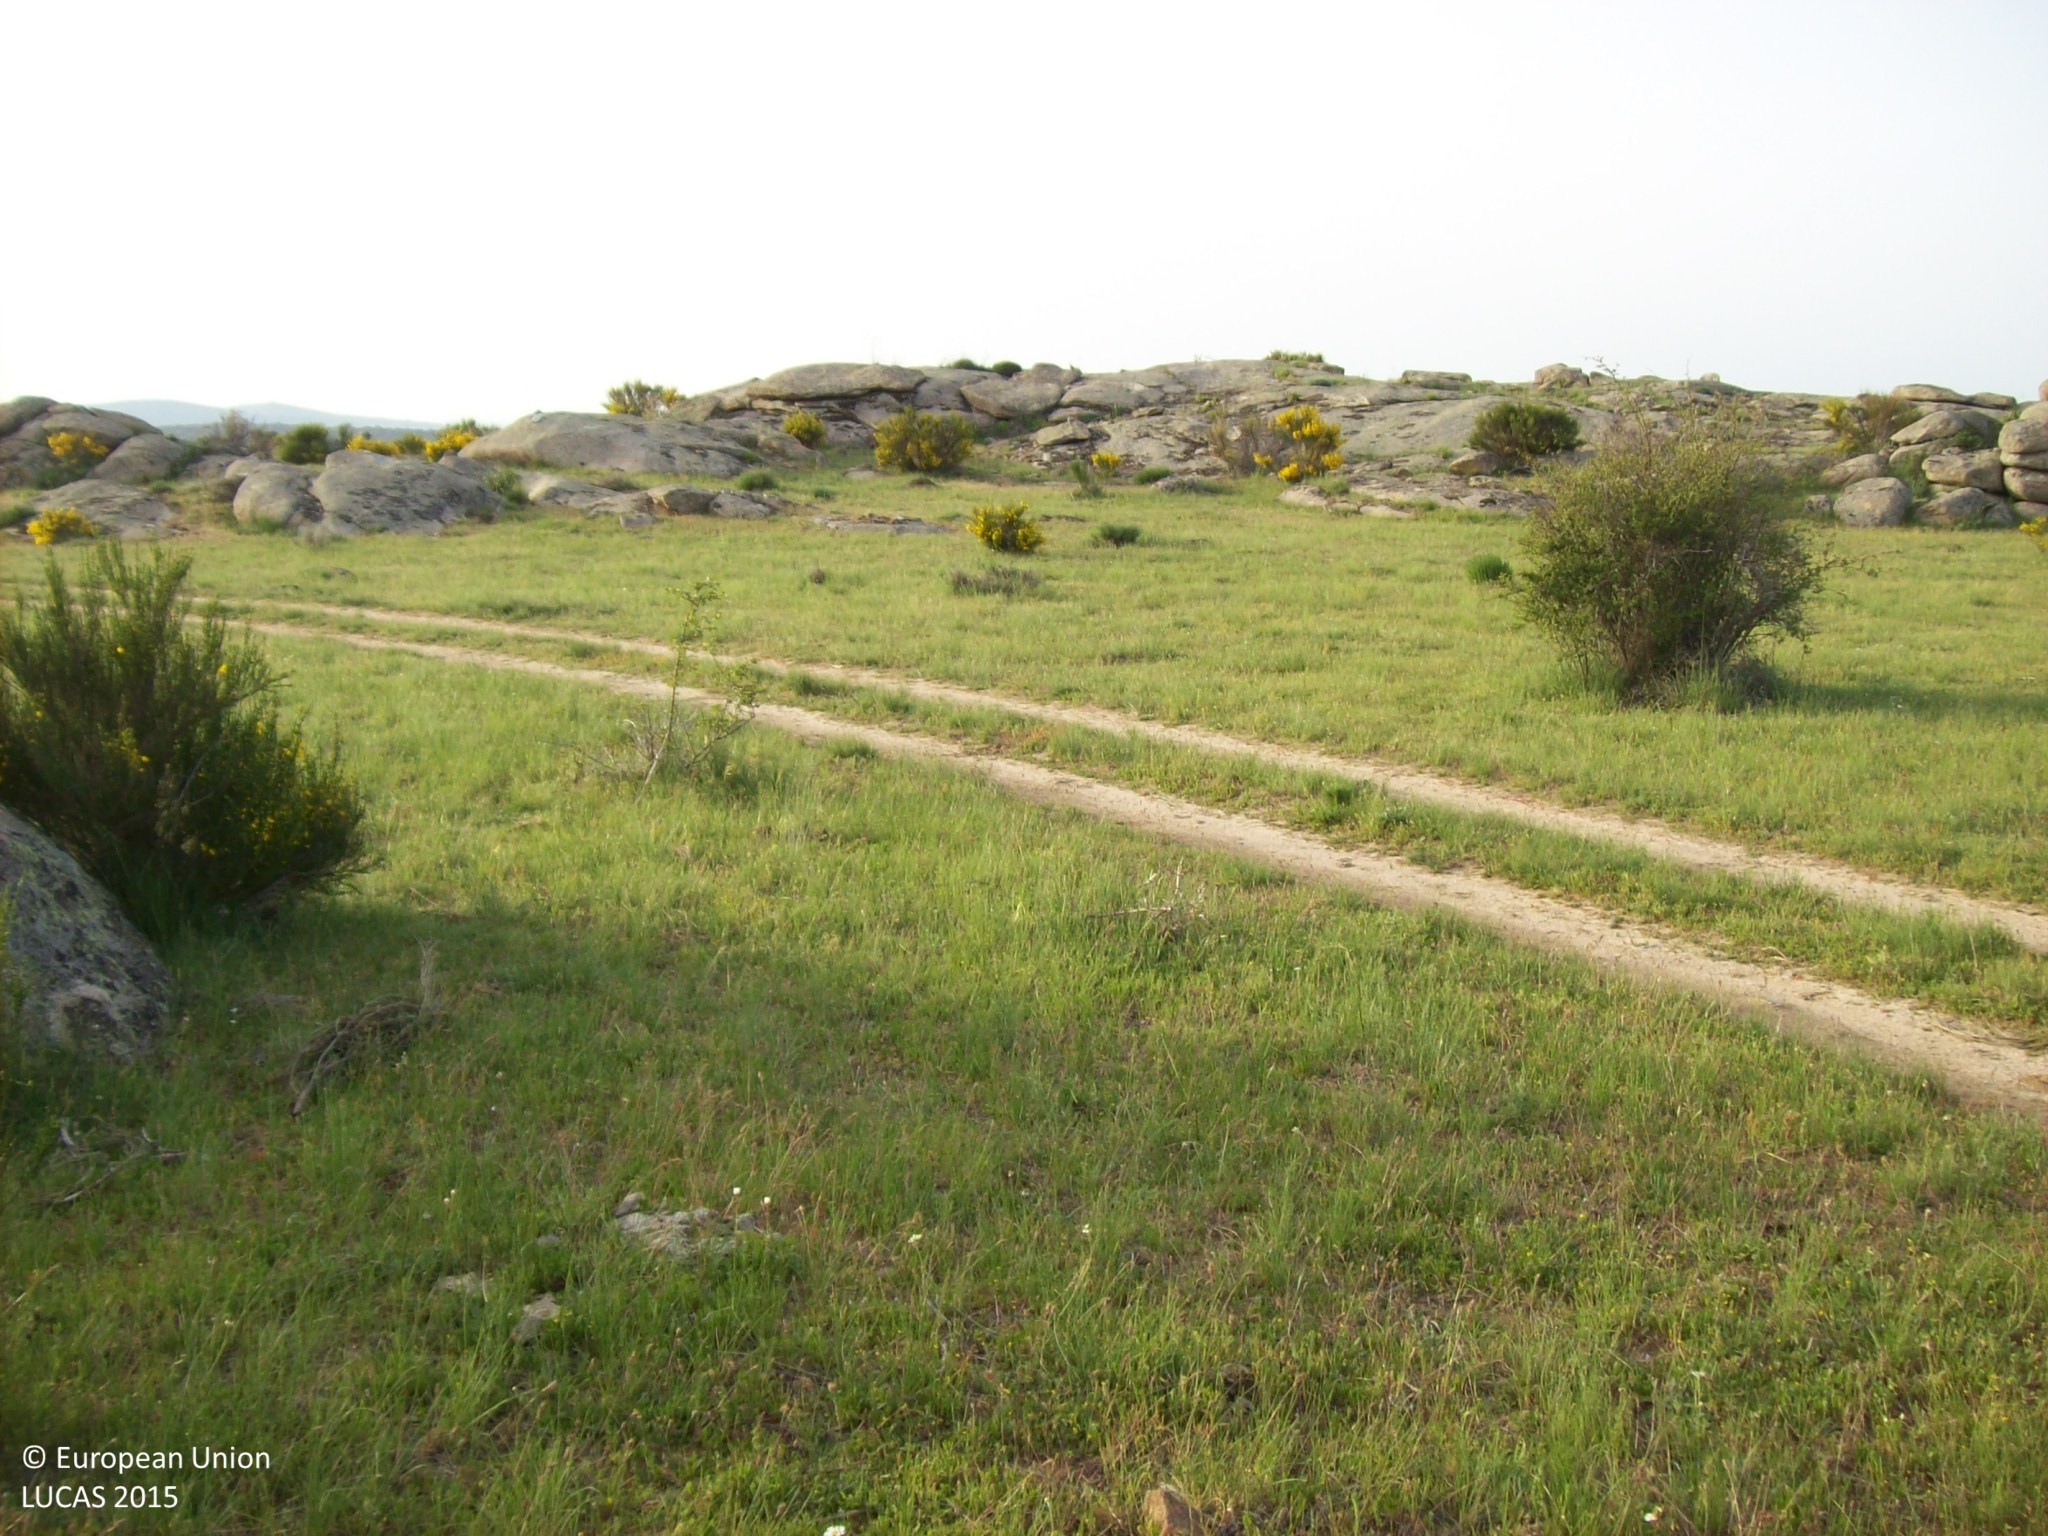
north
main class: Shrubland
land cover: Shrubland without tree cover
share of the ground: 10 - 25 %
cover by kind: consolidated bare surface 40 %, herbaceous plants 35 %, shrubs 20 %
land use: Agriculture (excluding fallow land and kitchen gardens)
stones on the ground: < 10 %
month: May
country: ES
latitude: 40.6992
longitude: -4.9124
